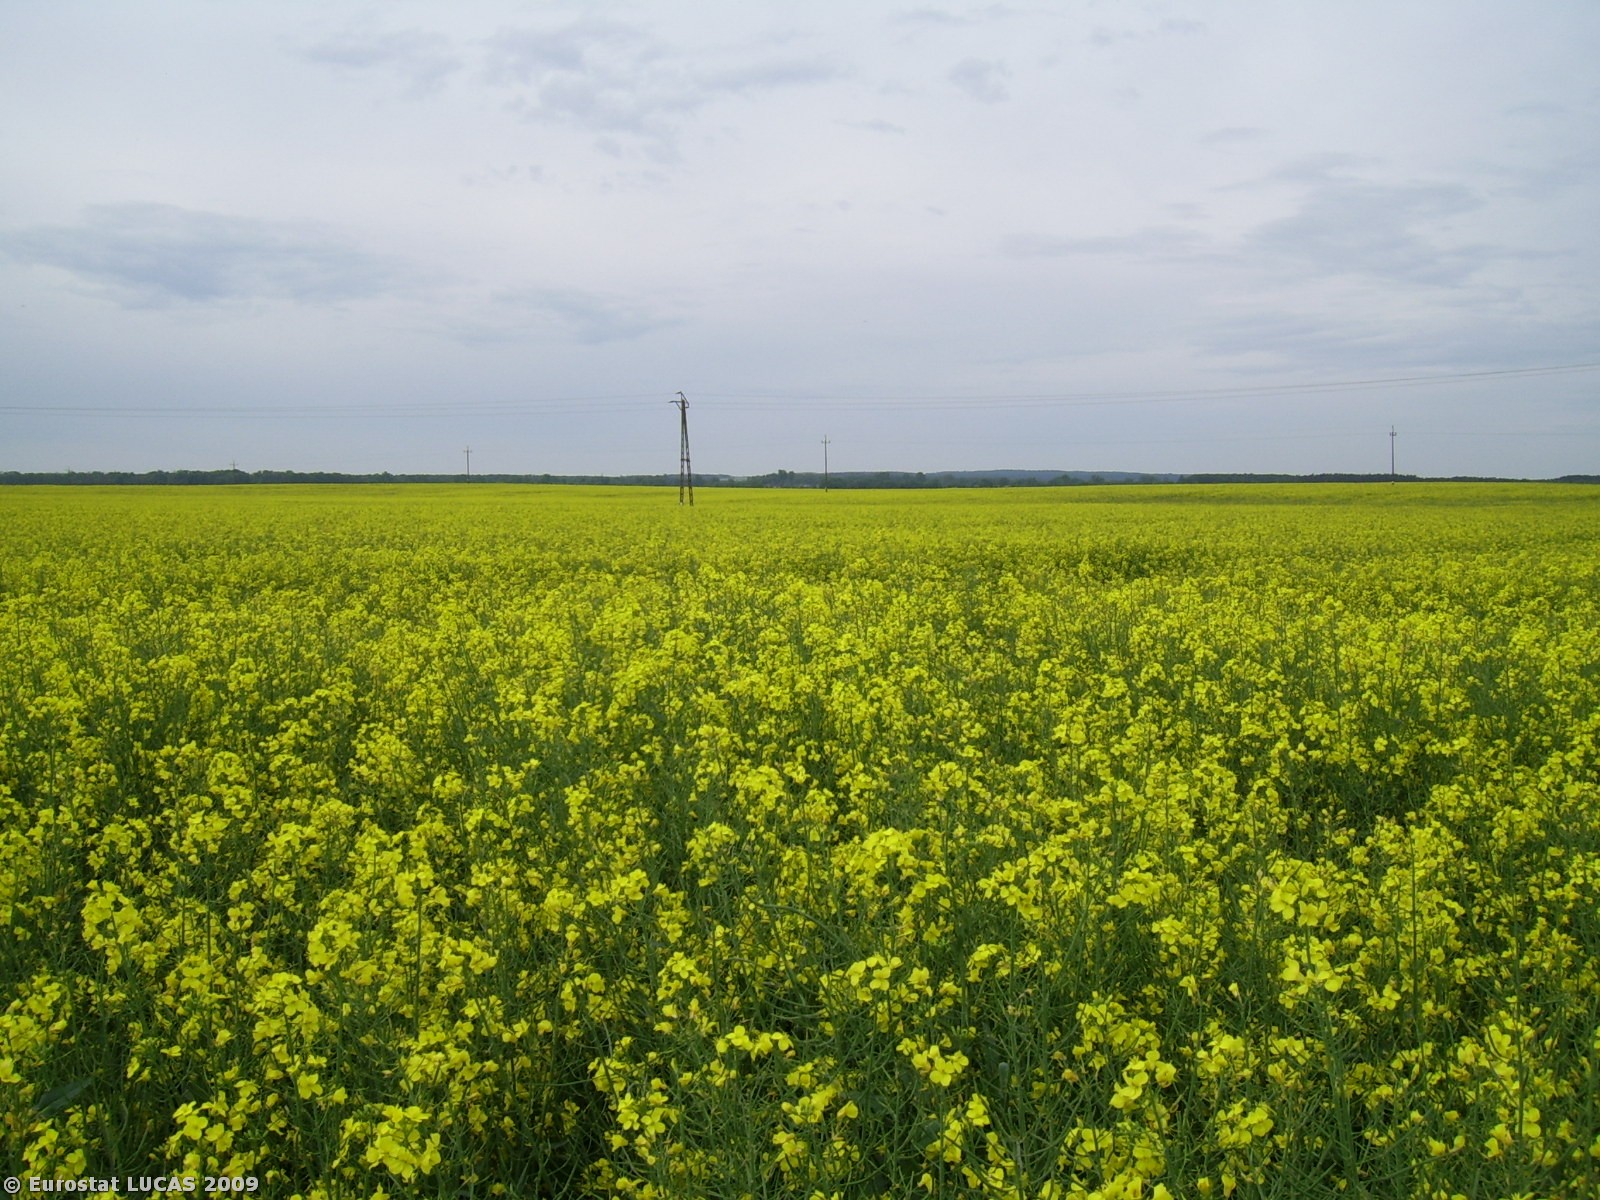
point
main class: Cropland
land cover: Rape and turnip rape
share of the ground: > 75 %
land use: Agriculture (excluding fallow land and kitchen gardens)
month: May
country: PL
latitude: 53.0147
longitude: 17.6597
